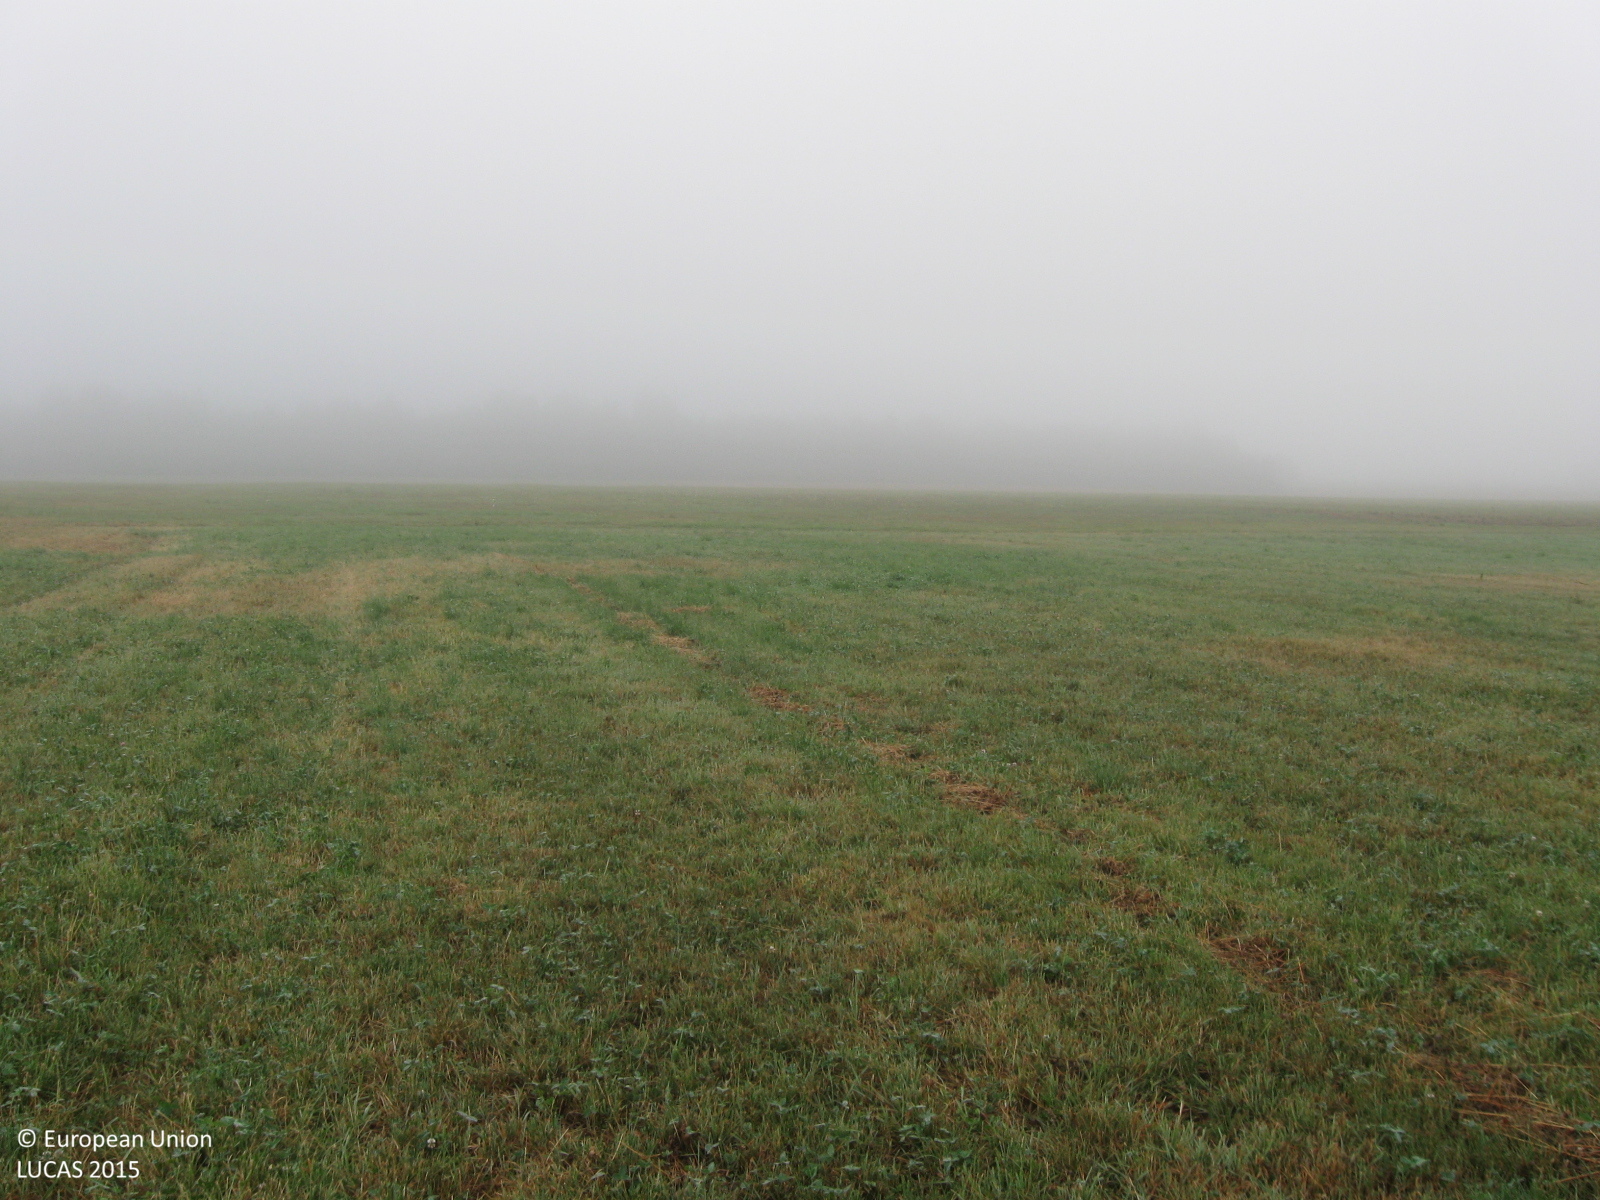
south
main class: Grassland
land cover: Grassland without tree/shrub cover
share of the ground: > 75 %
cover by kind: herbaceous plants 100 %
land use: Agriculture (excluding fallow land and kitchen gardens)
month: August
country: LT
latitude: 55.3050
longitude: 23.1639
